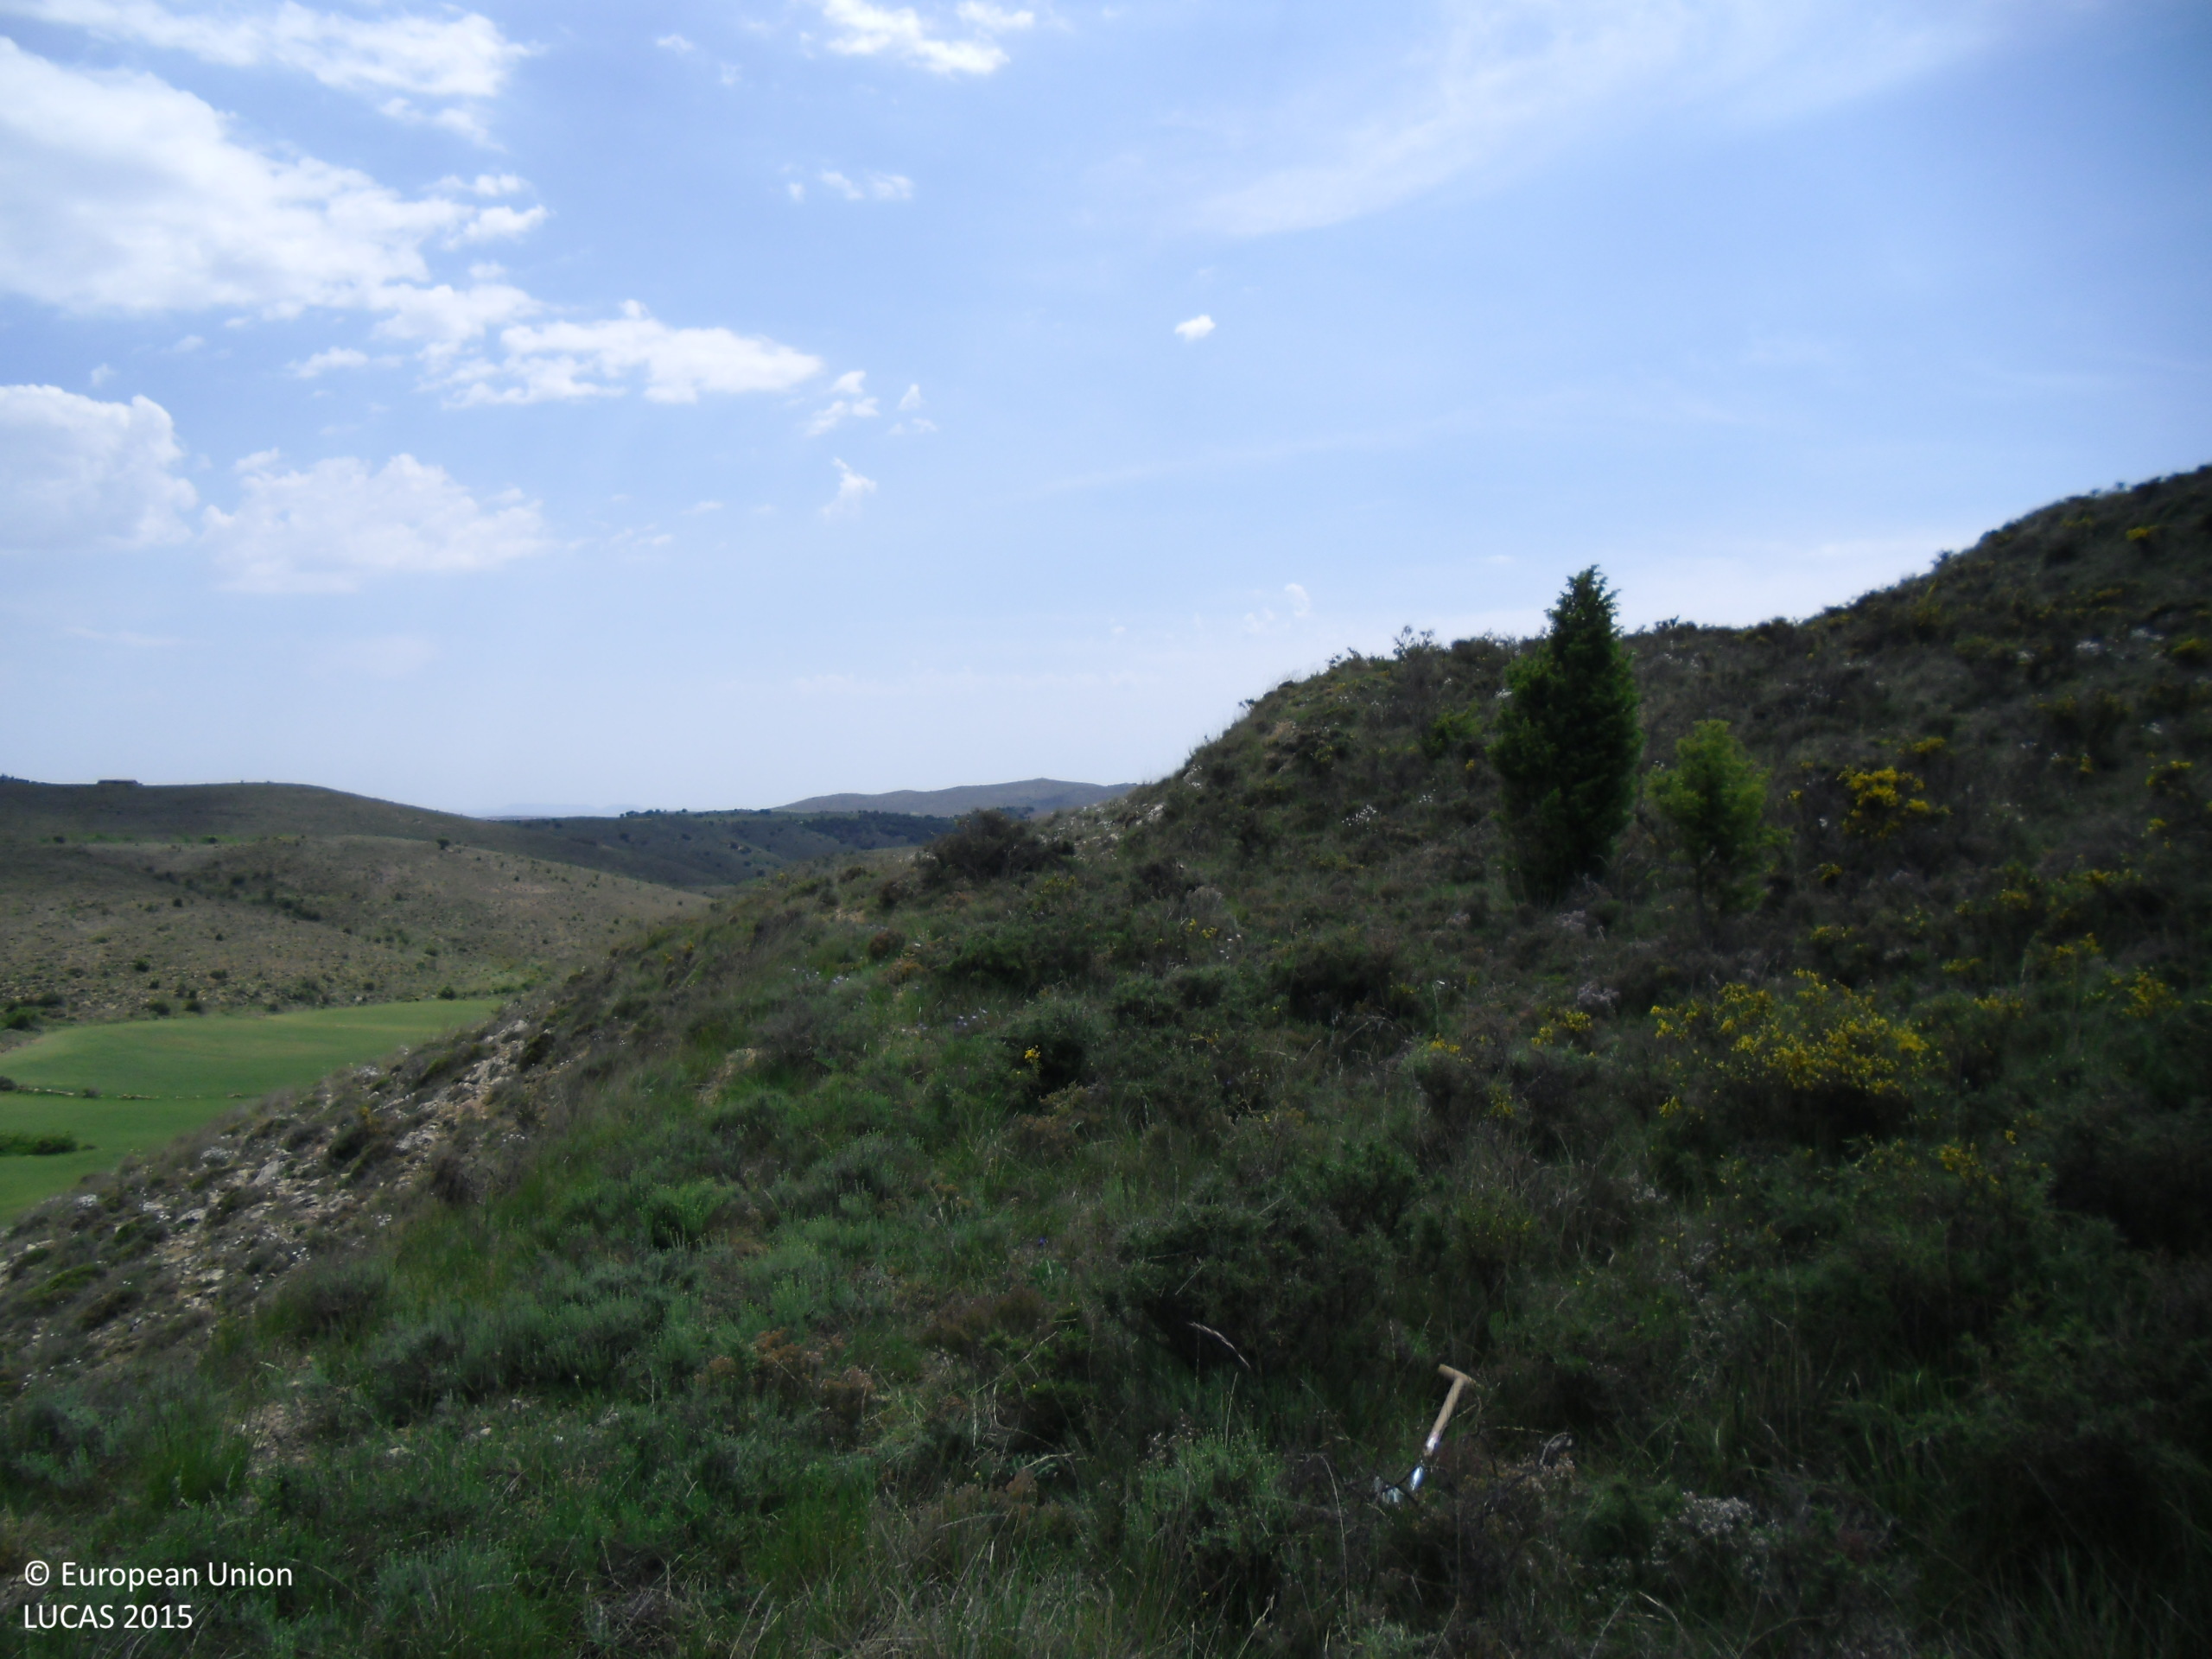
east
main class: Shrubland
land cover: Shrubland without tree cover
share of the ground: > 75 %
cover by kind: shrubs 80 %, herbaceous plants 20 %
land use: Agriculture (excluding fallow land and kitchen gardens)
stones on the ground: < 10 %
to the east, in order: Shrubland without tree cover; Shrubland with sparse tree cover
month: May
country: ES
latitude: 40.8828
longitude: -0.8732
